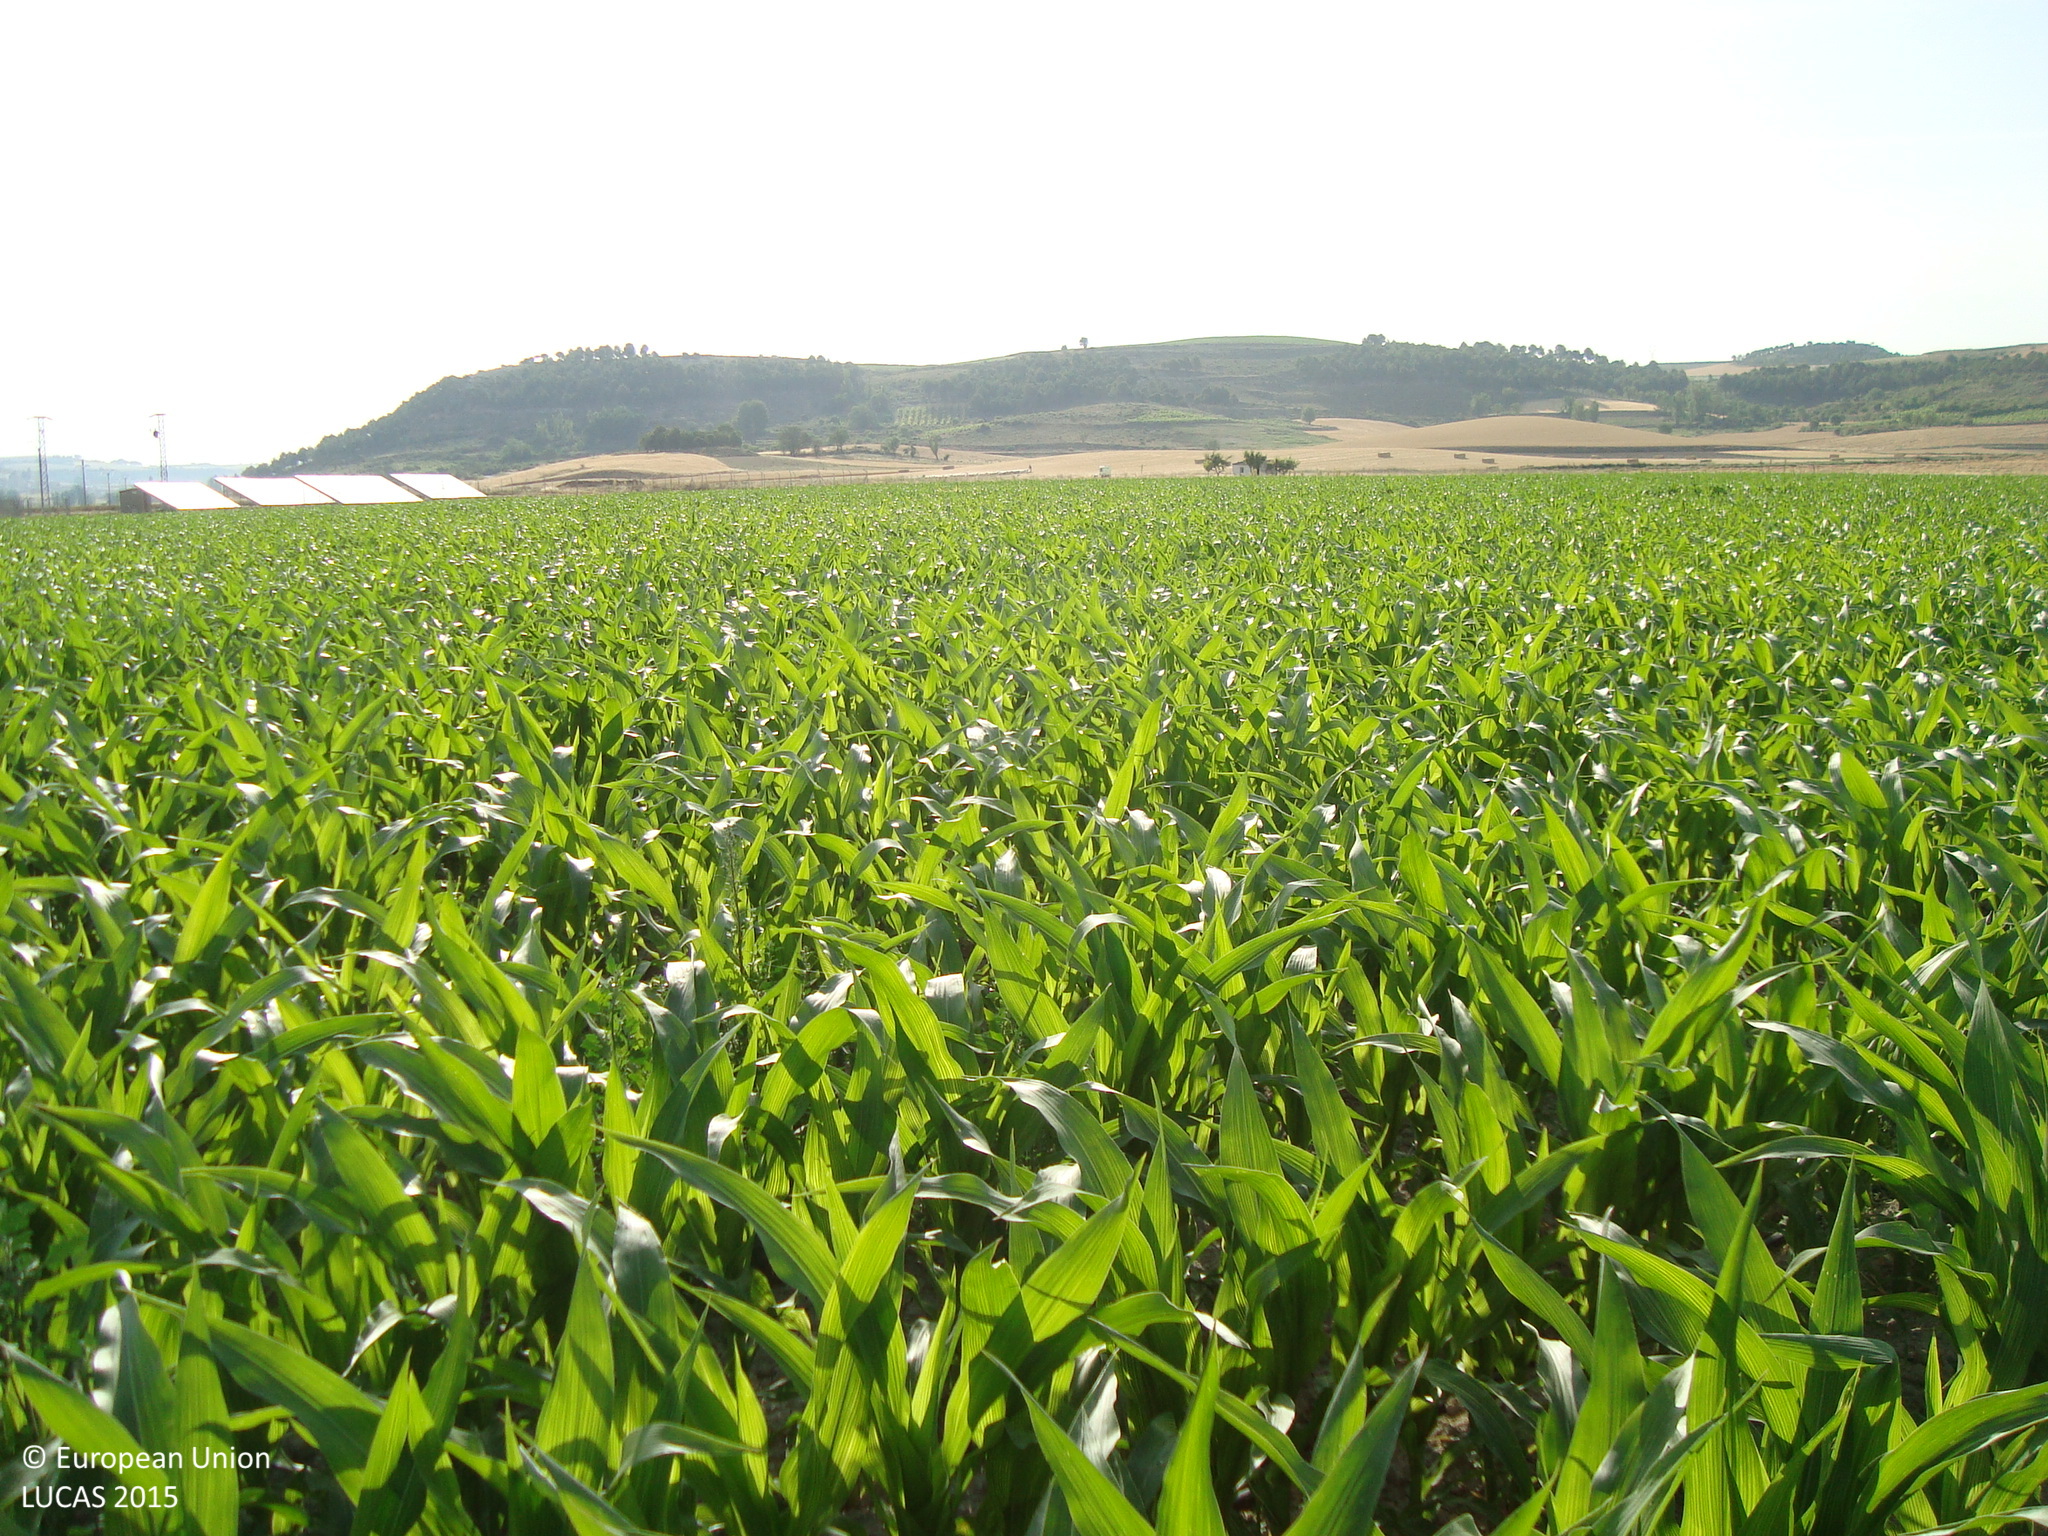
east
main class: Cropland
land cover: Maize
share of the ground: > 75 %
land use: Agriculture (excluding fallow land and kitchen gardens)
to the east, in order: Maize; Barley; Grass margins; Tracks; Spontaneously vegetated surfaces
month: July
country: ES
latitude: 41.7552
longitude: -4.2174
